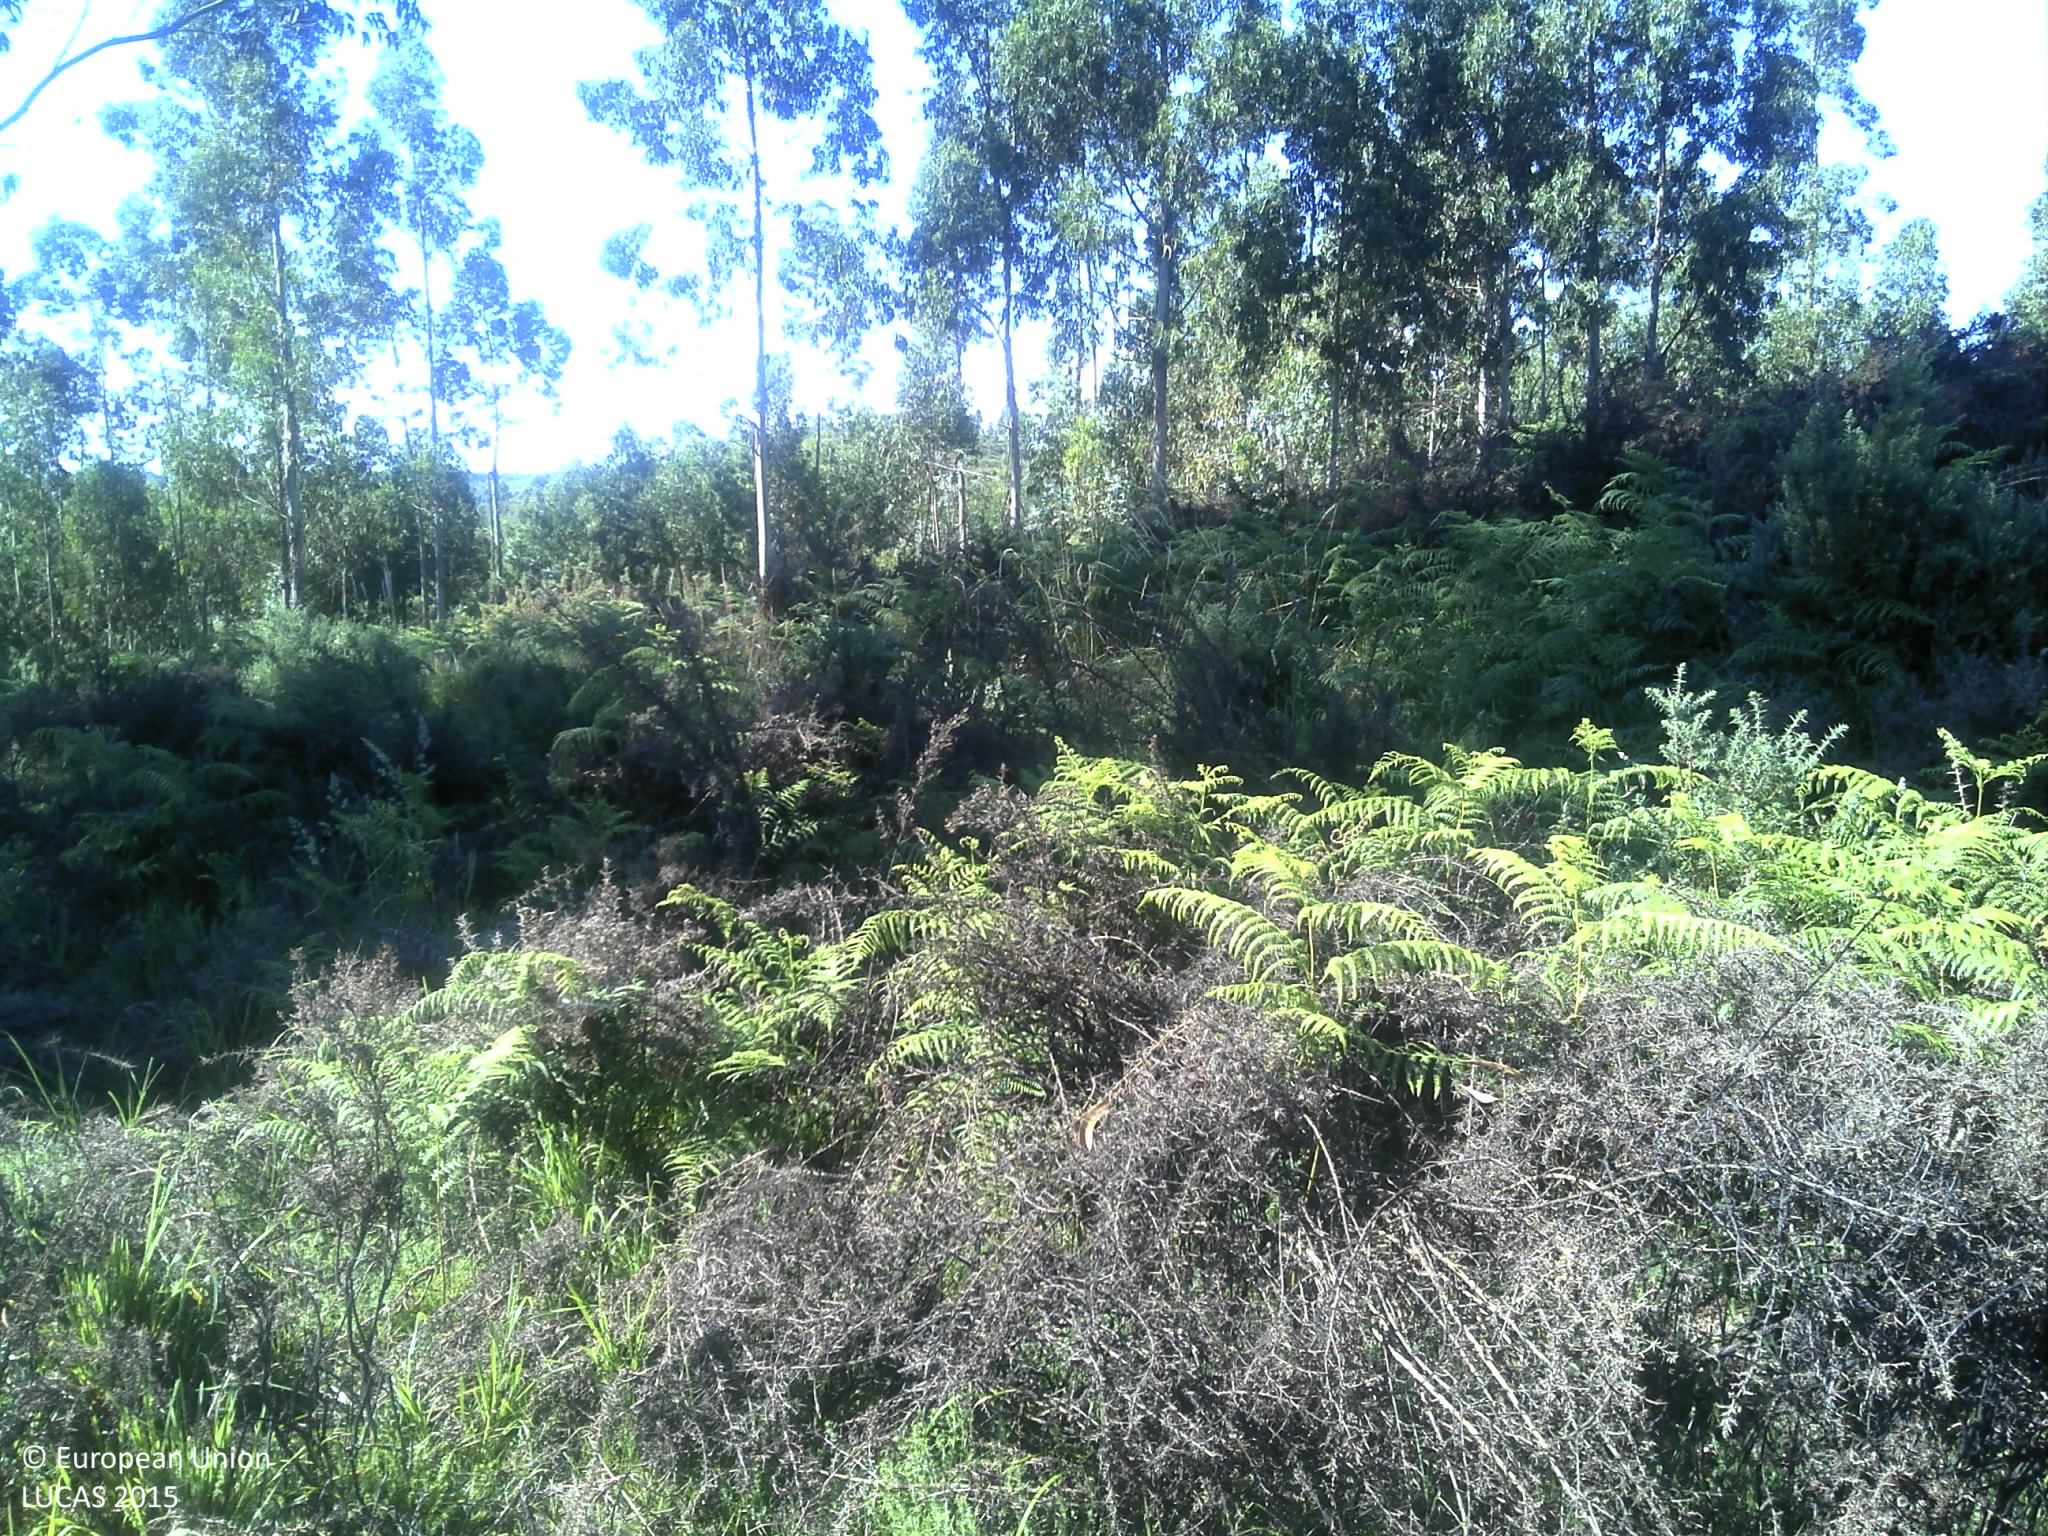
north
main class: Shrubland
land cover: Shrubland without tree cover
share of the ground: > 75 %
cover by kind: shrubs 85 %, herbaceous plants 10 %, unconsolidated bare surface 5 %
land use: Agriculture (excluding fallow land and kitchen gardens)
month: June
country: PT
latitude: 41.4836
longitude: -8.2192
